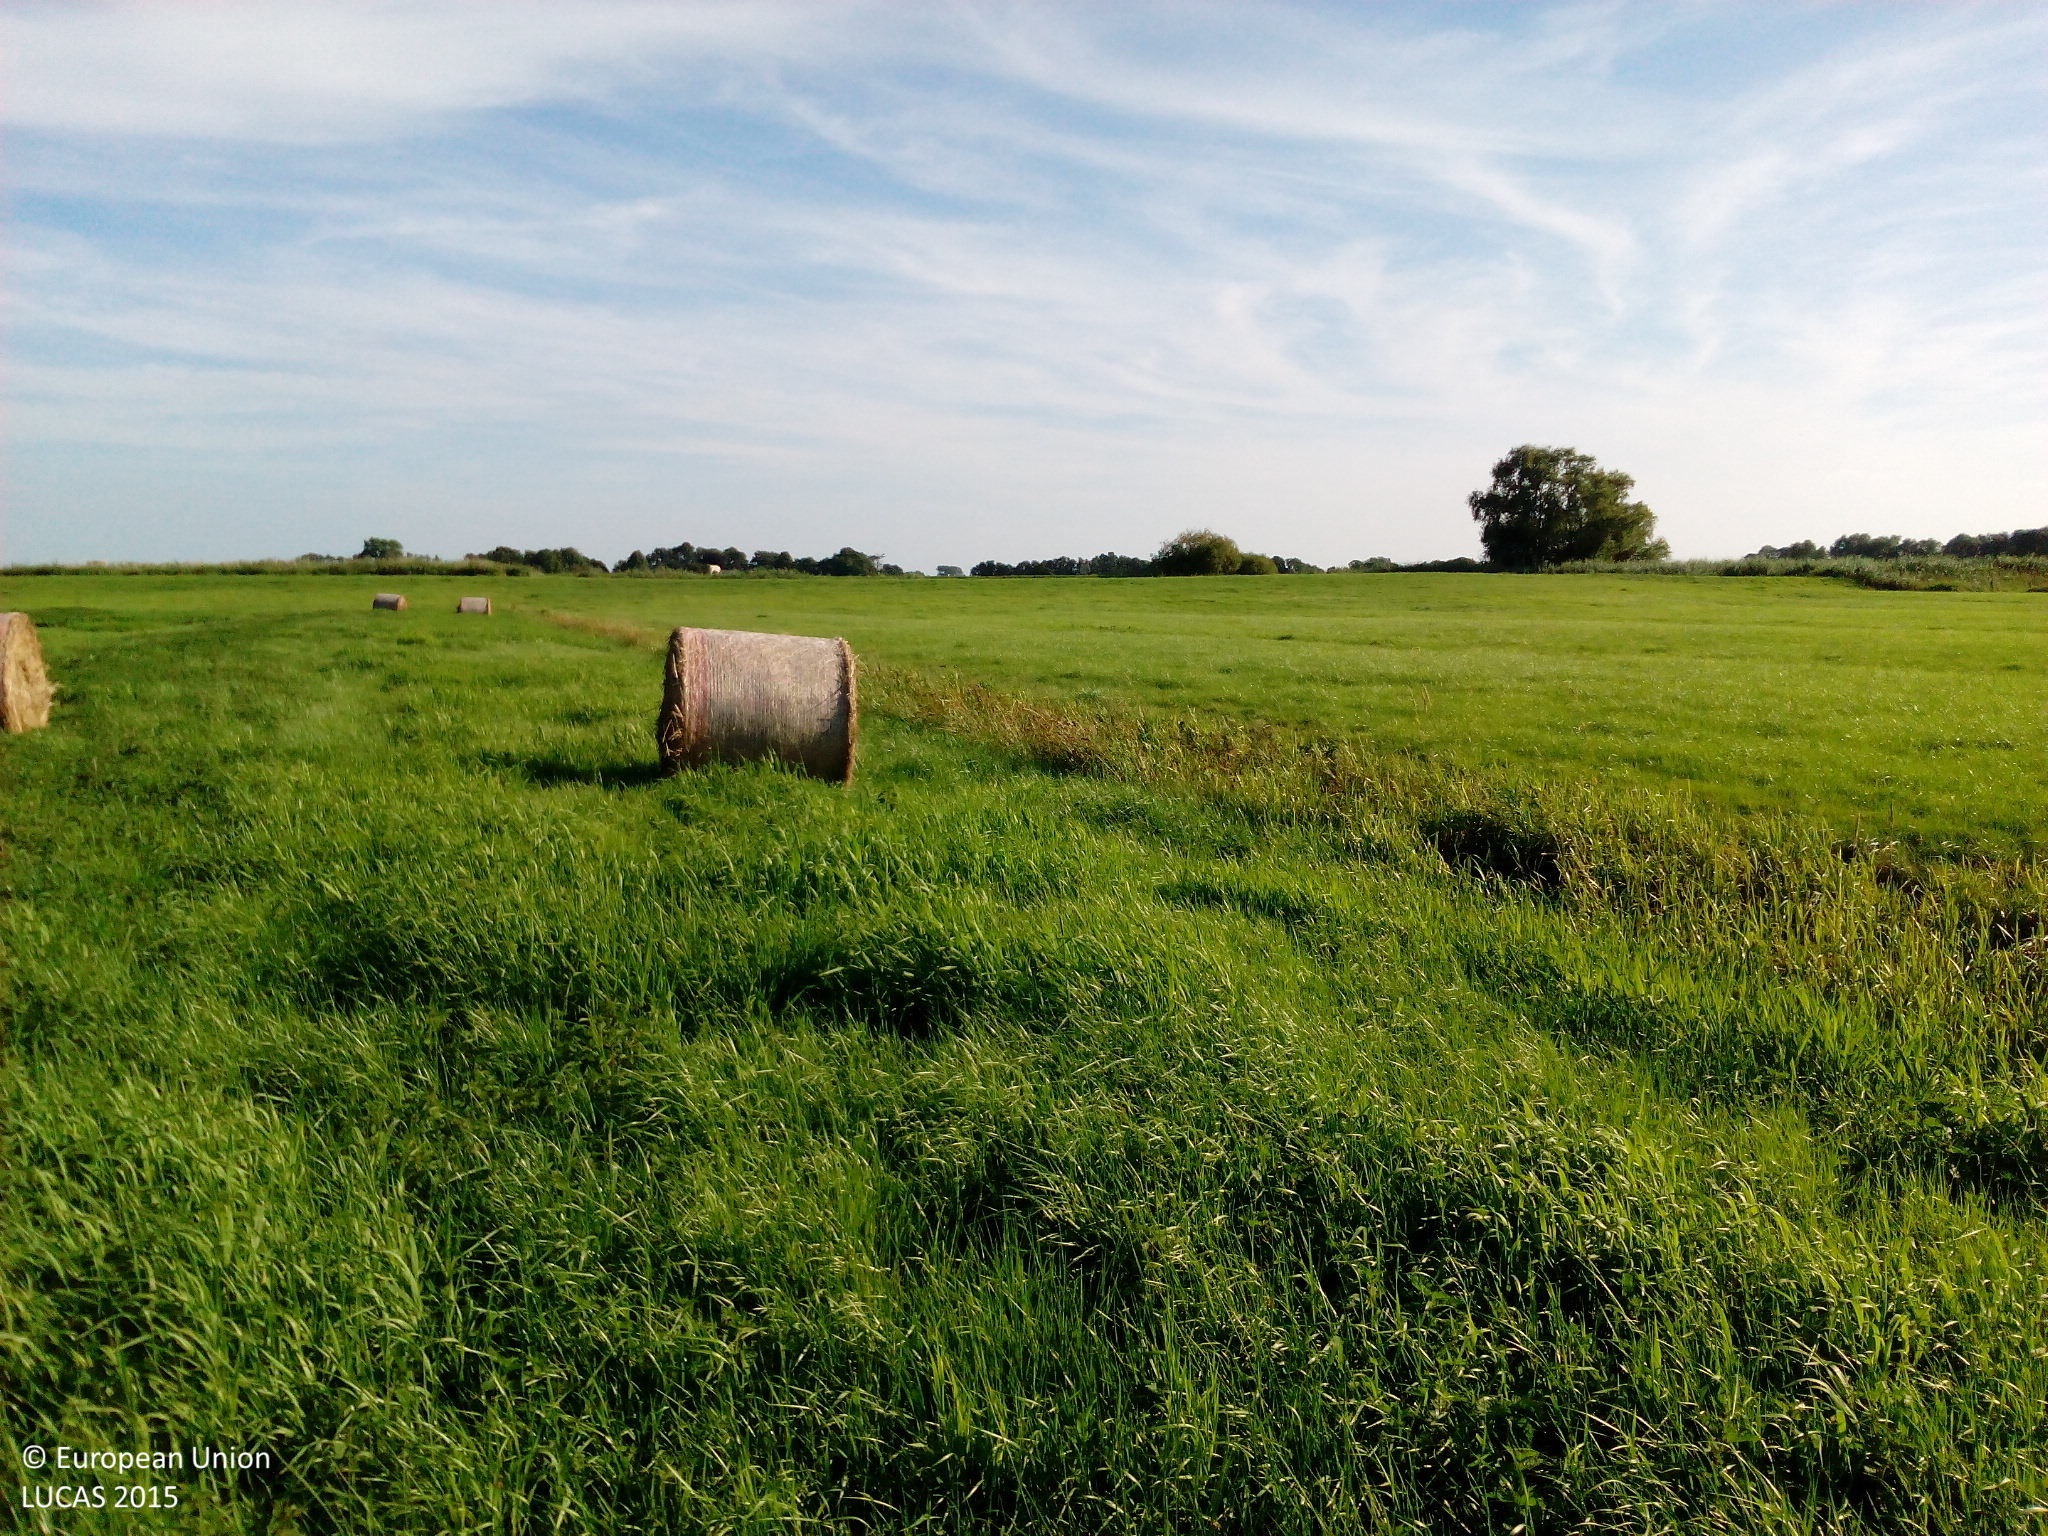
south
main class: Grassland
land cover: Grassland without tree/shrub cover
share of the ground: > 75 %
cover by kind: herbaceous plants 100 %
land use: Agriculture (excluding fallow land and kitchen gardens)
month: August
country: DE
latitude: 53.9406
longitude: 9.6498
